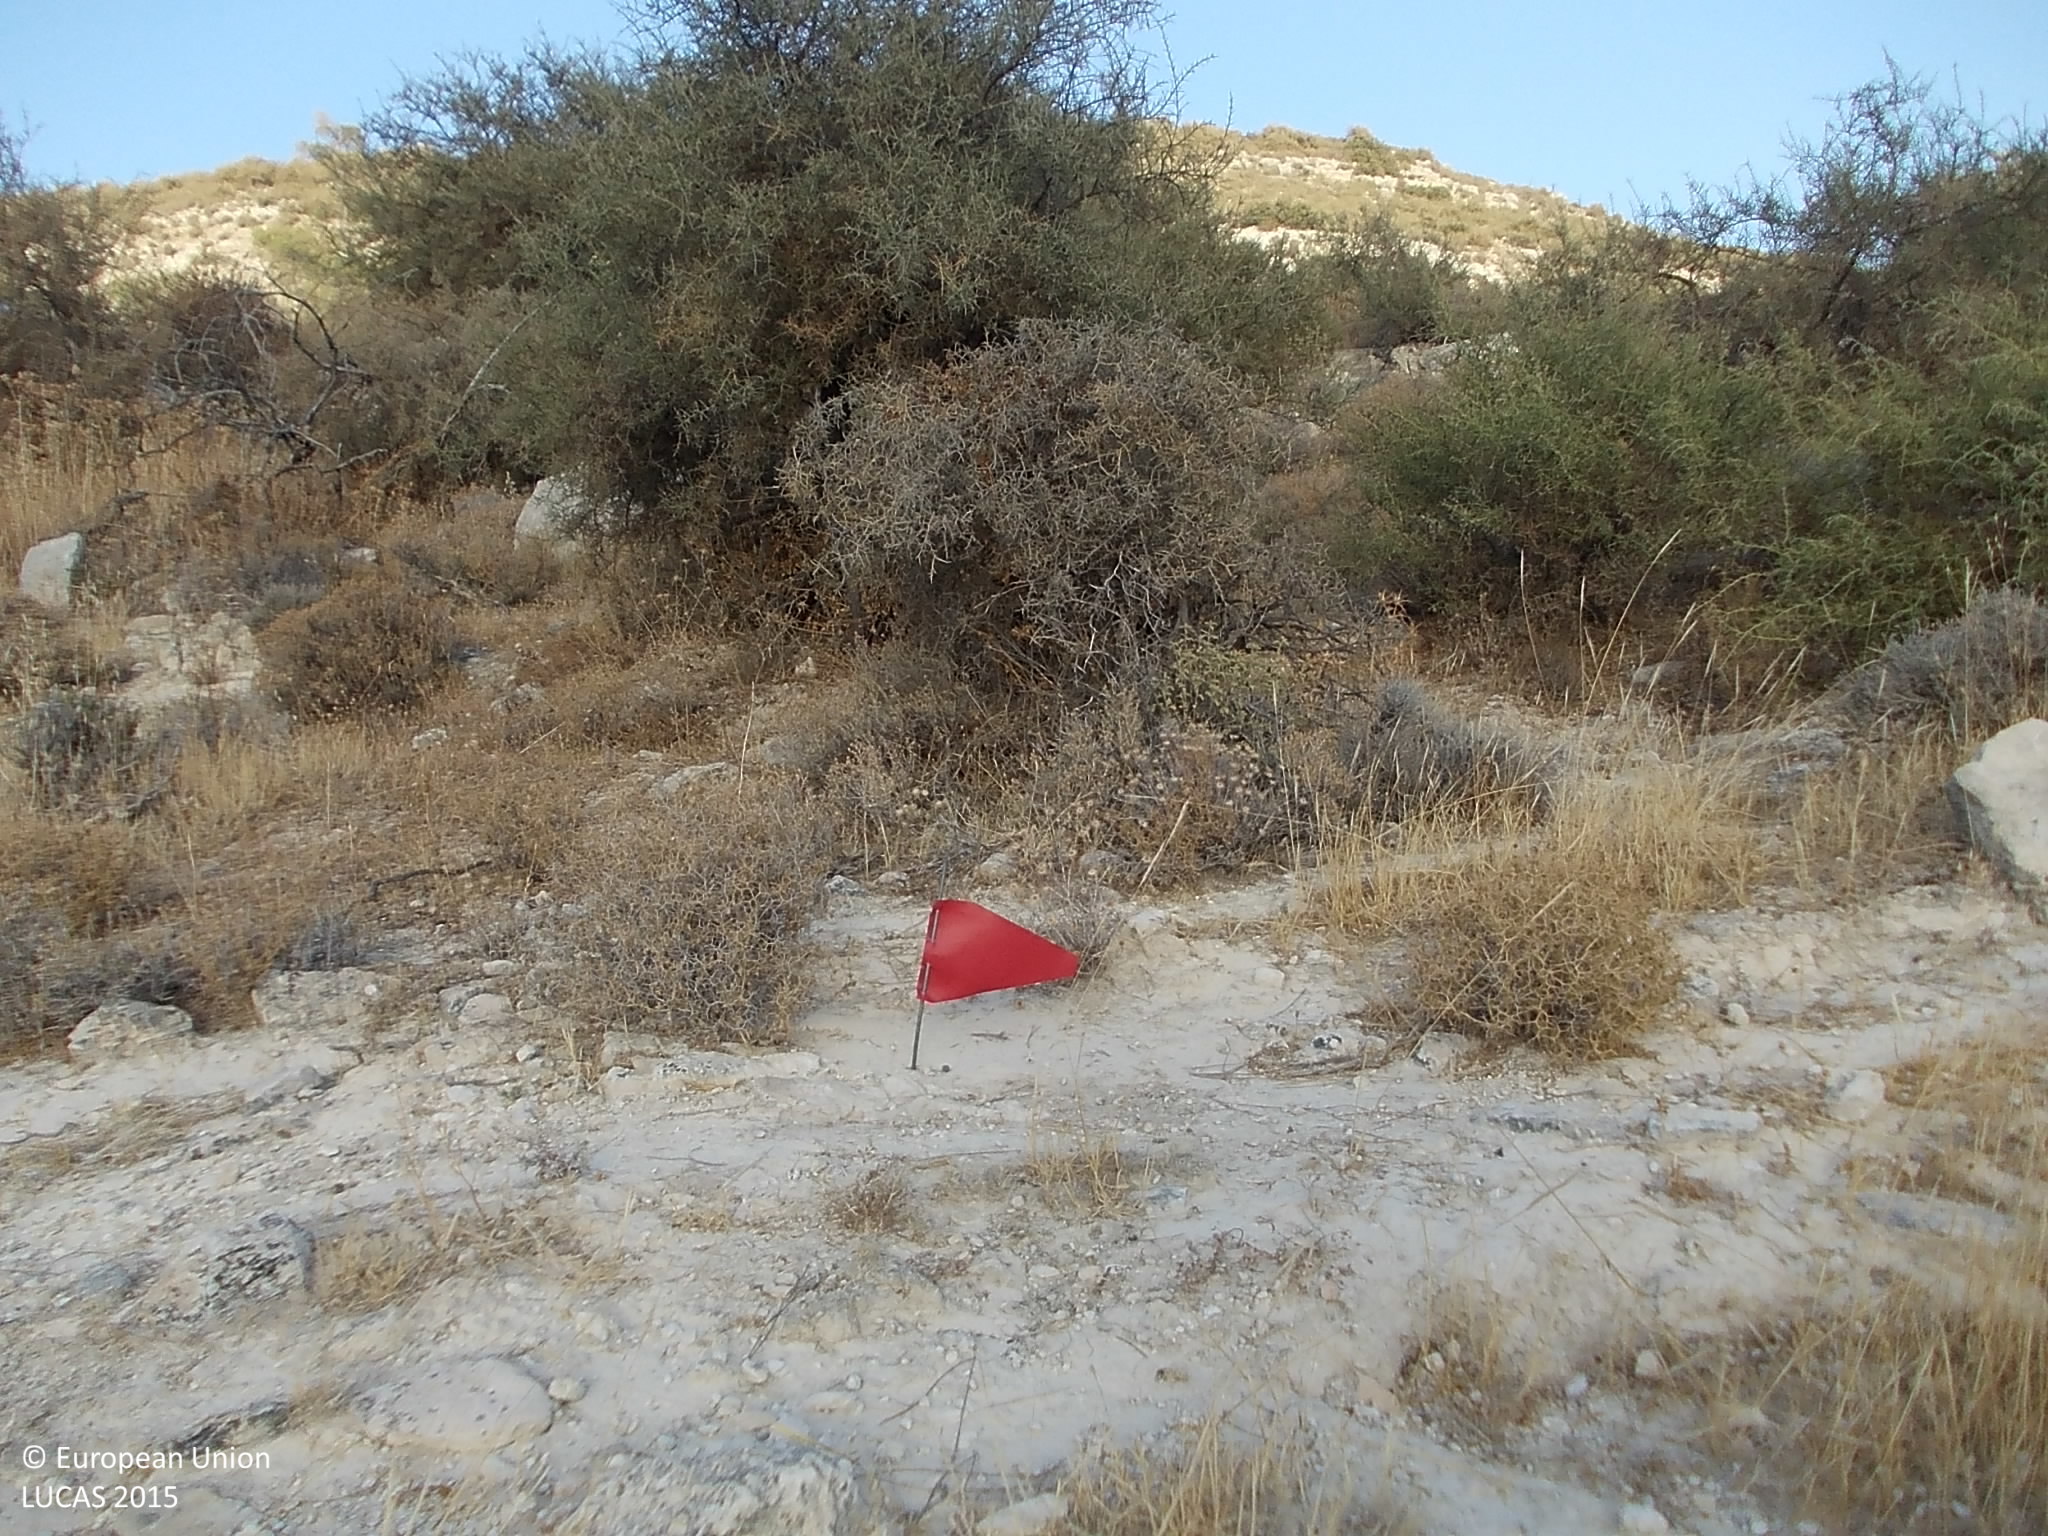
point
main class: Shrubland
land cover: Shrubland without tree cover
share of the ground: 50 - 75 %
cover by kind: shrubs 60 %, consolidated bare surface 20 %, herbaceous plants 10 %, unconsolidated bare surface 10 %
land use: Semi-natural and natural areas not in use
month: September
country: CY
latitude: 34.7064
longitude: 32.9022
